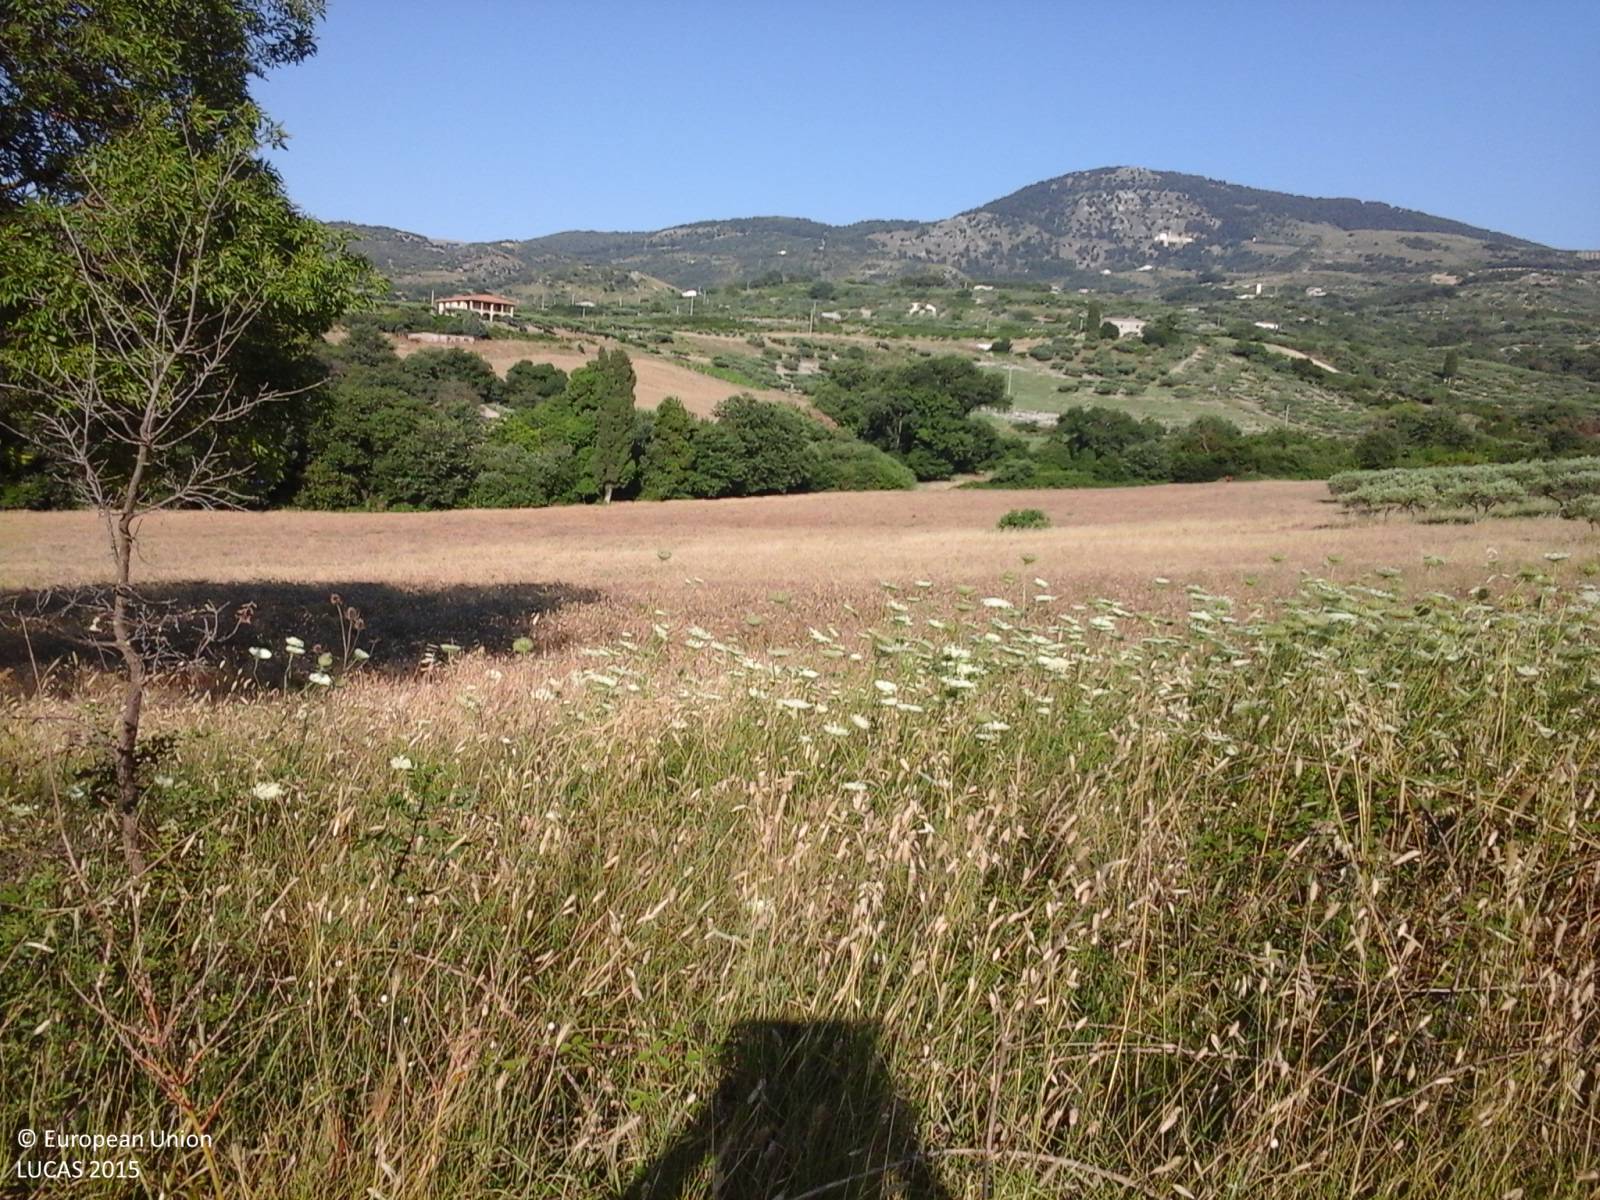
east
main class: Cropland
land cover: Durum wheat
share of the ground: > 75 %
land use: Agriculture (excluding fallow land and kitchen gardens)
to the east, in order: Durum wheat; Shrubland with sparse tree cover; Inland fresh running water; Shrubland with sparse tree cover; Permanent crops (only in case pi); Broadleaved woodland; Durum wheat
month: July
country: IT
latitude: 37.7289
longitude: 13.2324
